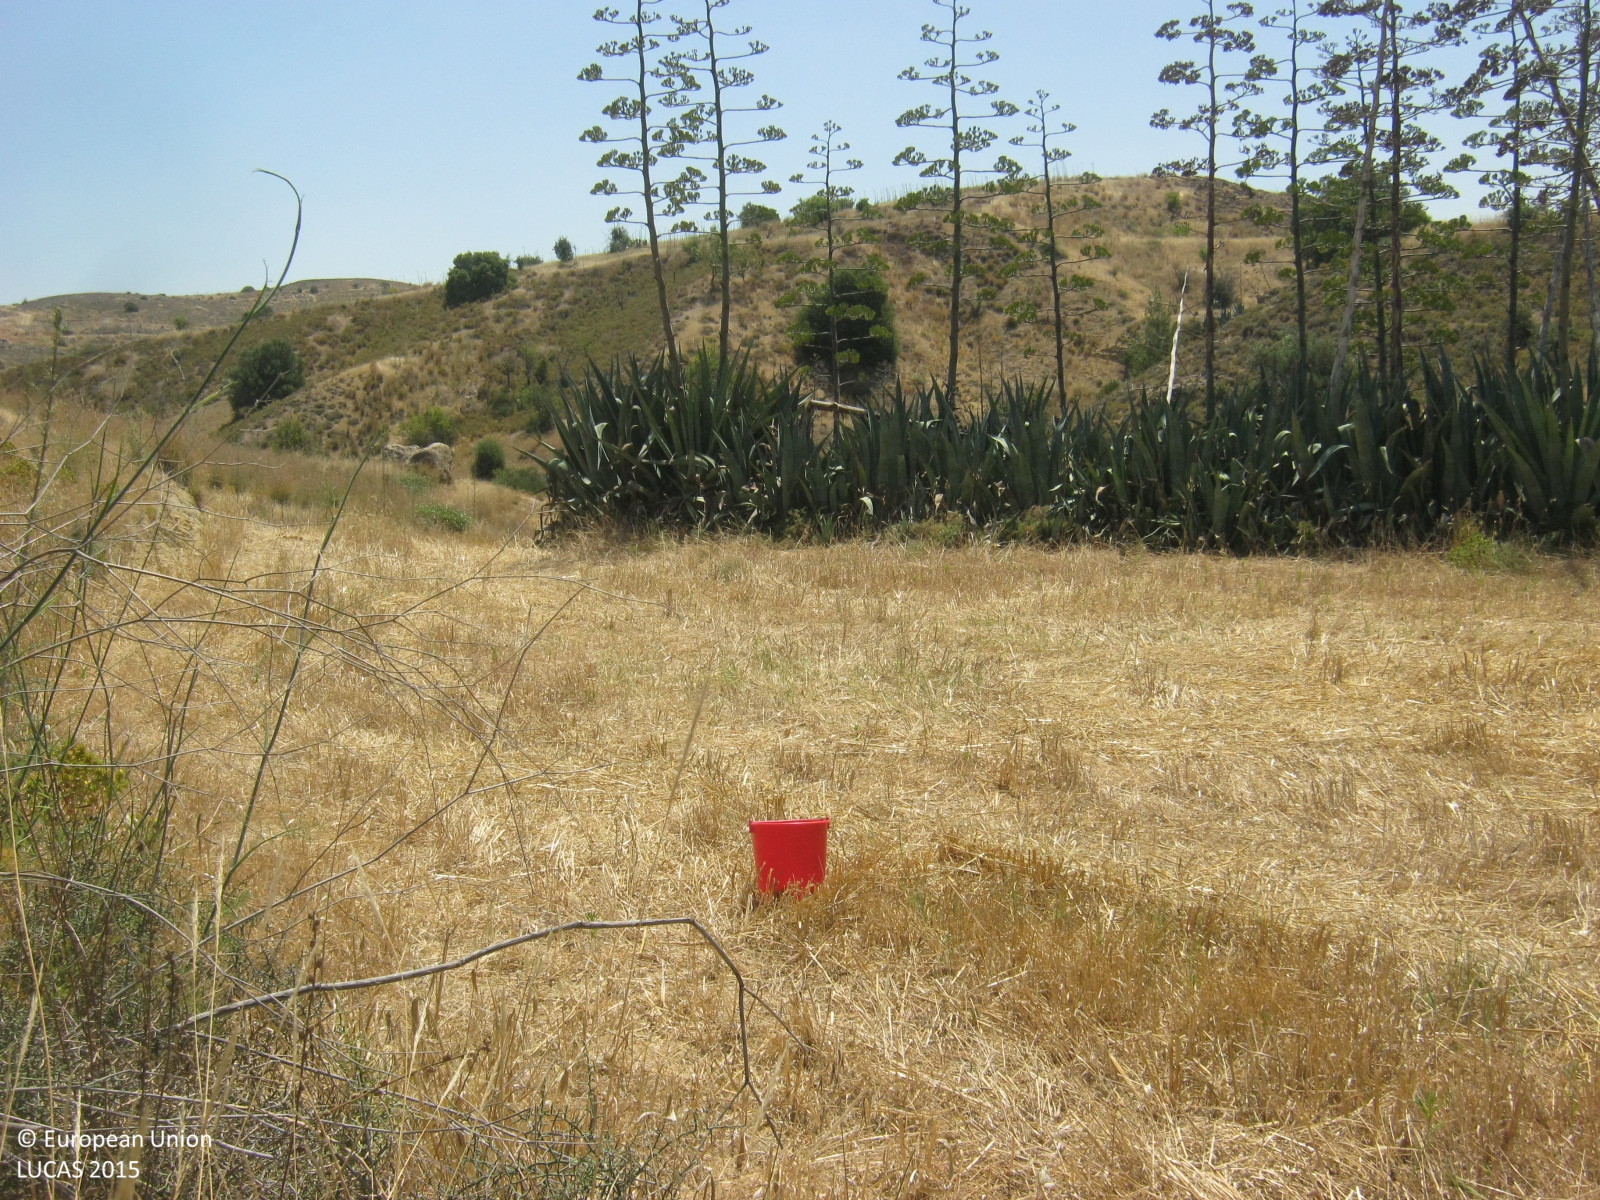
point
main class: Cropland
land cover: Common wheat
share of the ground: < 10 %
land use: Agriculture (excluding fallow land and kitchen gardens)
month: June
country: CY
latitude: 35.0552
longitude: 33.1515
